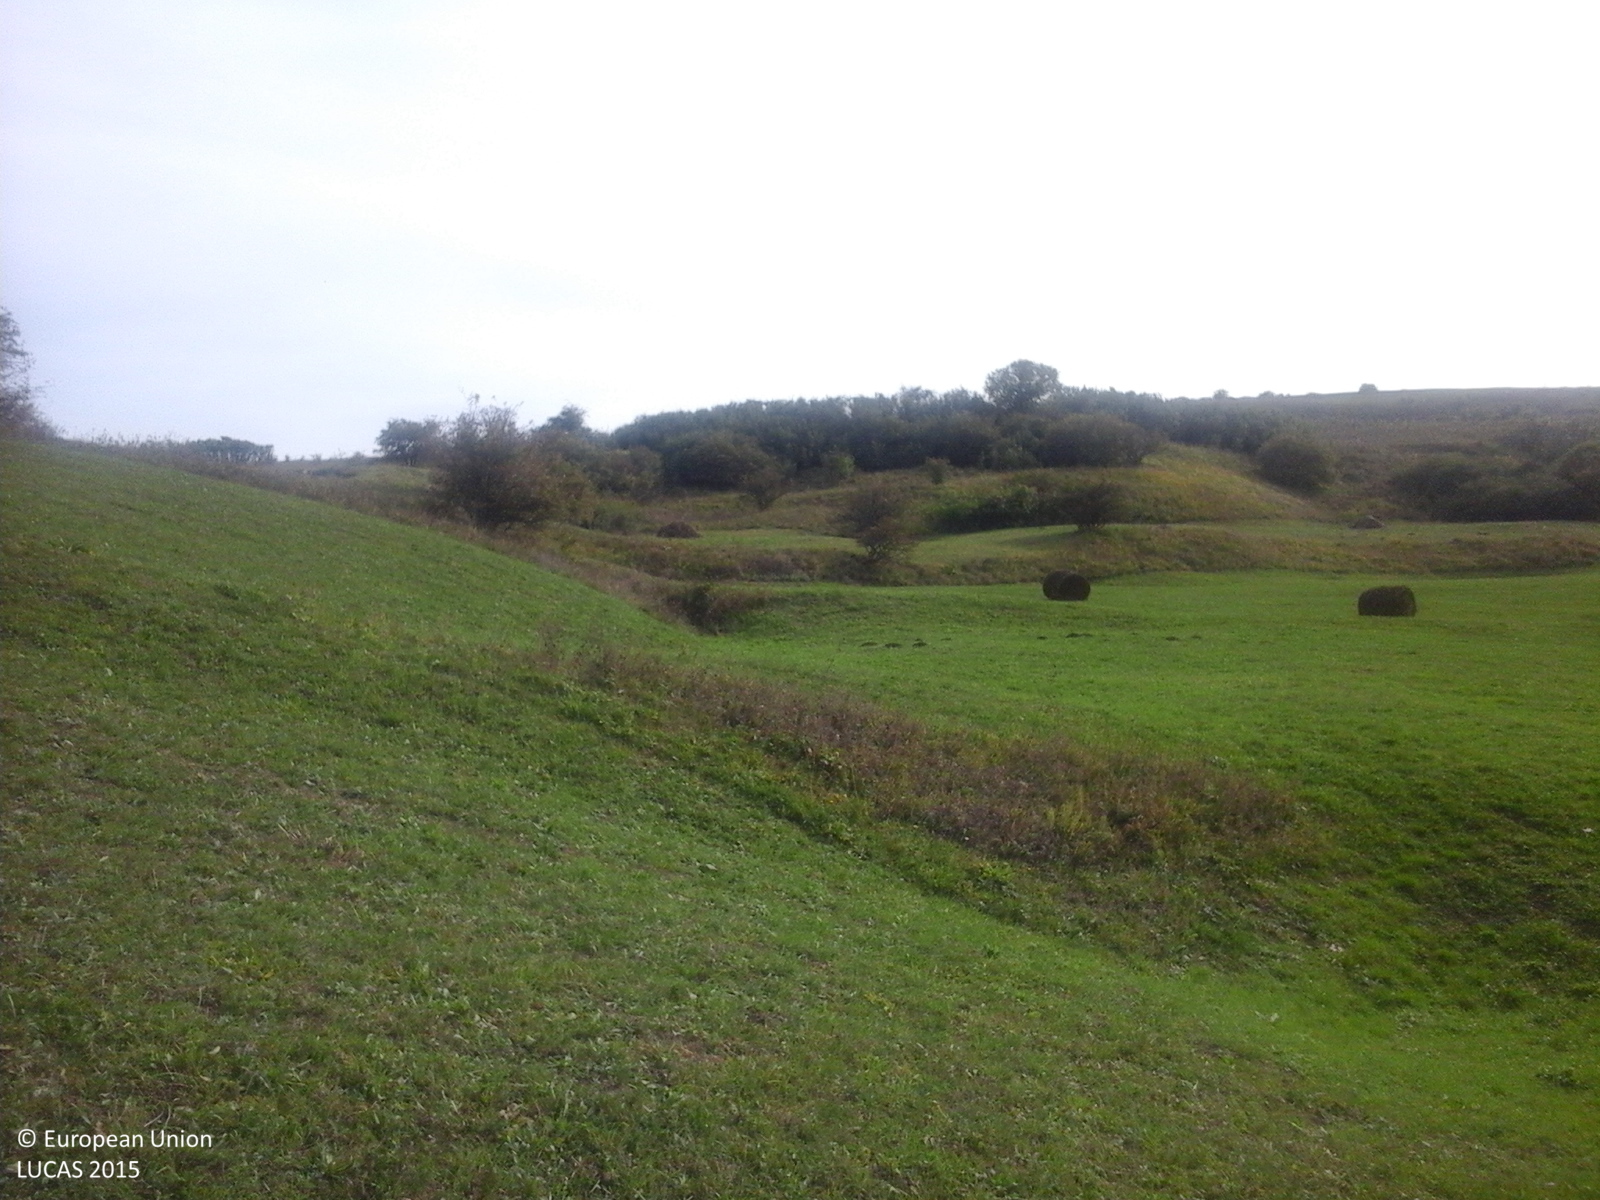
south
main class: Grassland
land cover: Grassland without tree/shrub cover
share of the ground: > 75 %
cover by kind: herbaceous plants 100 %
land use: Agriculture (excluding fallow land and kitchen gardens)
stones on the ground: < 10 %
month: September
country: RO
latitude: 46.9150
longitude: 23.6364
